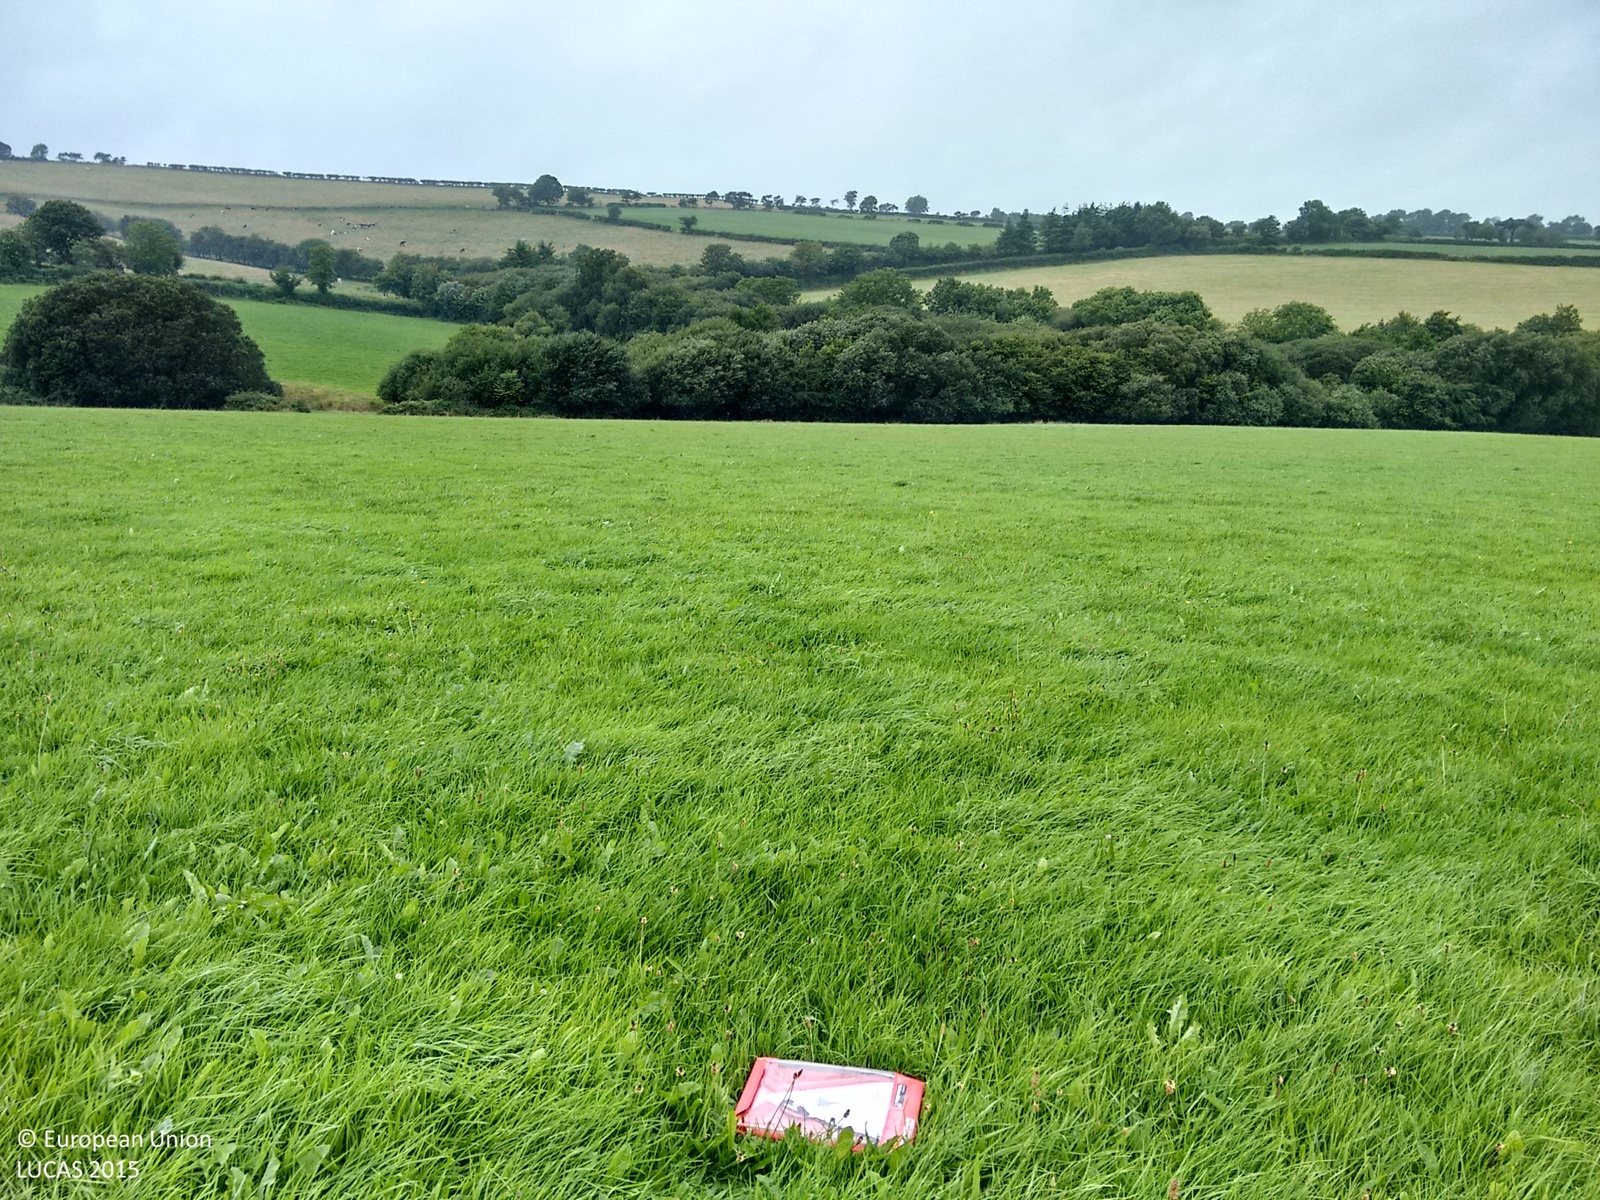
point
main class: Grassland
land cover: Grassland without tree/shrub cover
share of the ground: > 75 %
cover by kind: herbaceous plants 100 %
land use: Agriculture (excluding fallow land and kitchen gardens)
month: August
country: GB
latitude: 52.0162
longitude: -4.4570
